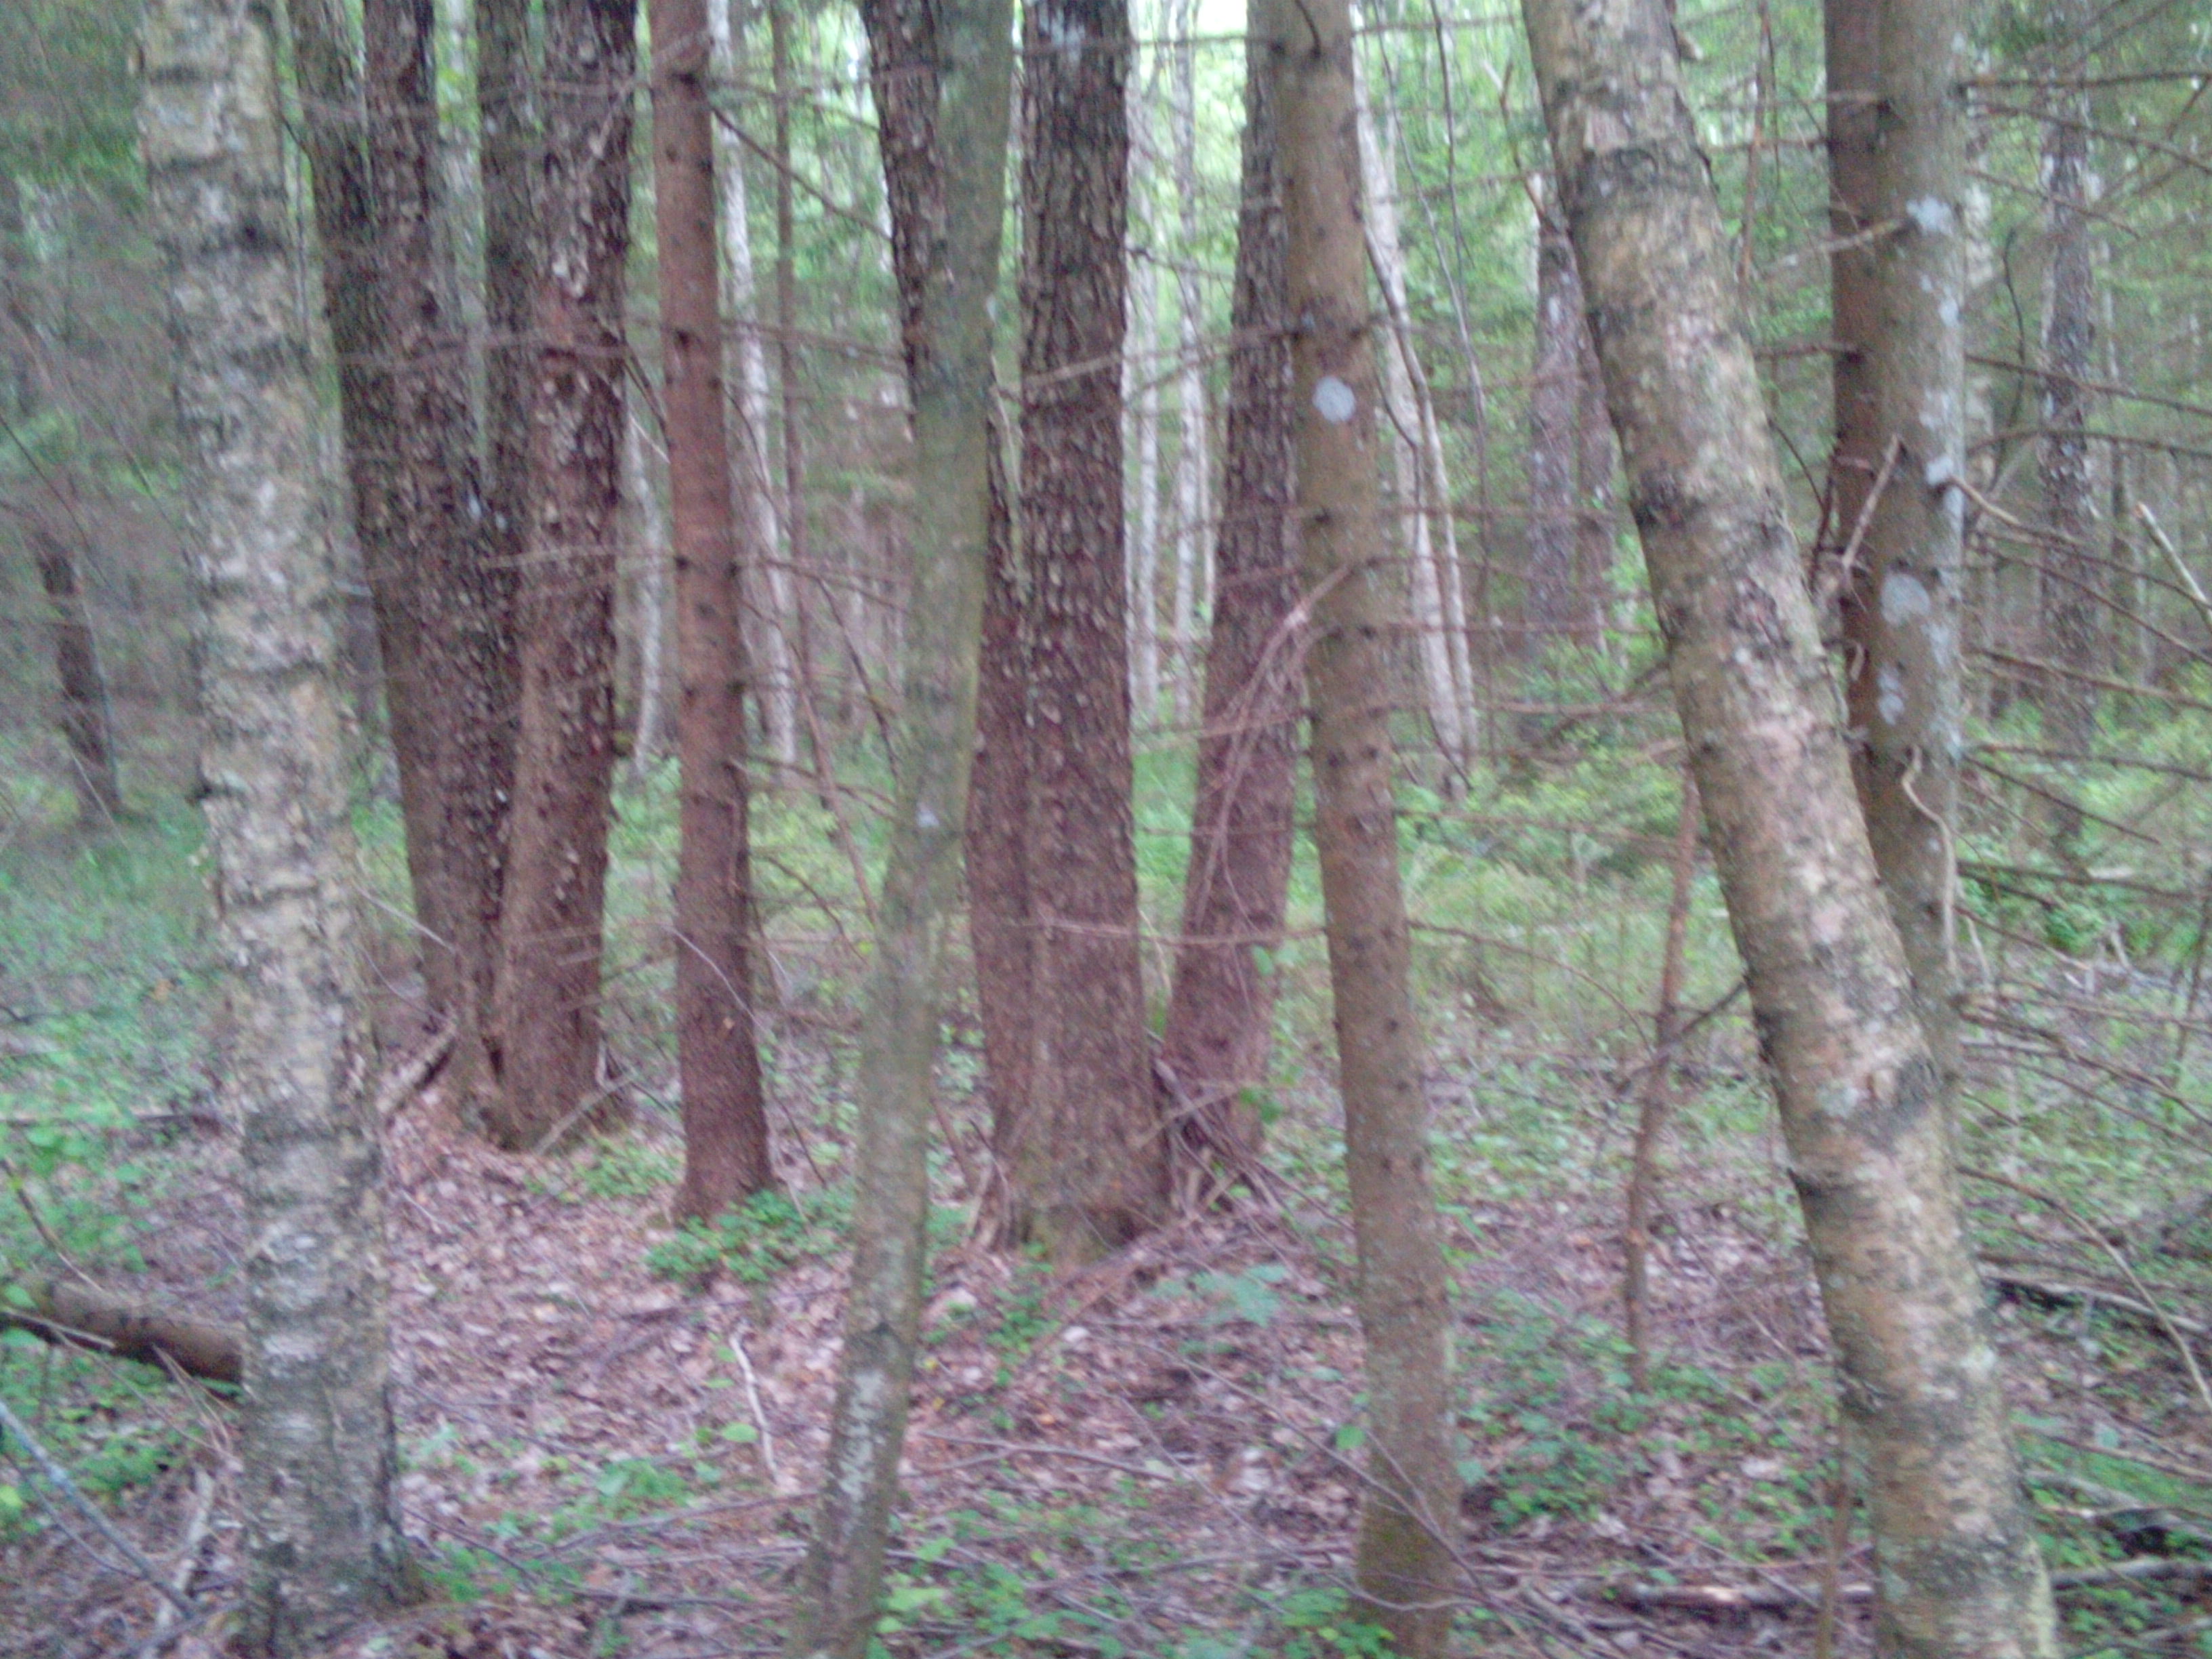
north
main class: Woodland
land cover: Spruce dominated mixed woodland
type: hemiboreal forest and nemoral coniferous forest and mixed broadleaved-coniferous forest
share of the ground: > 75 %
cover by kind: coniferous forest trees 70 %, broadleaved forest trees 25 %, herbaceous plants 5 %
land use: Forestry
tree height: > 5 m
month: June
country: LV
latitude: 56.8299
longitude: 22.1279
